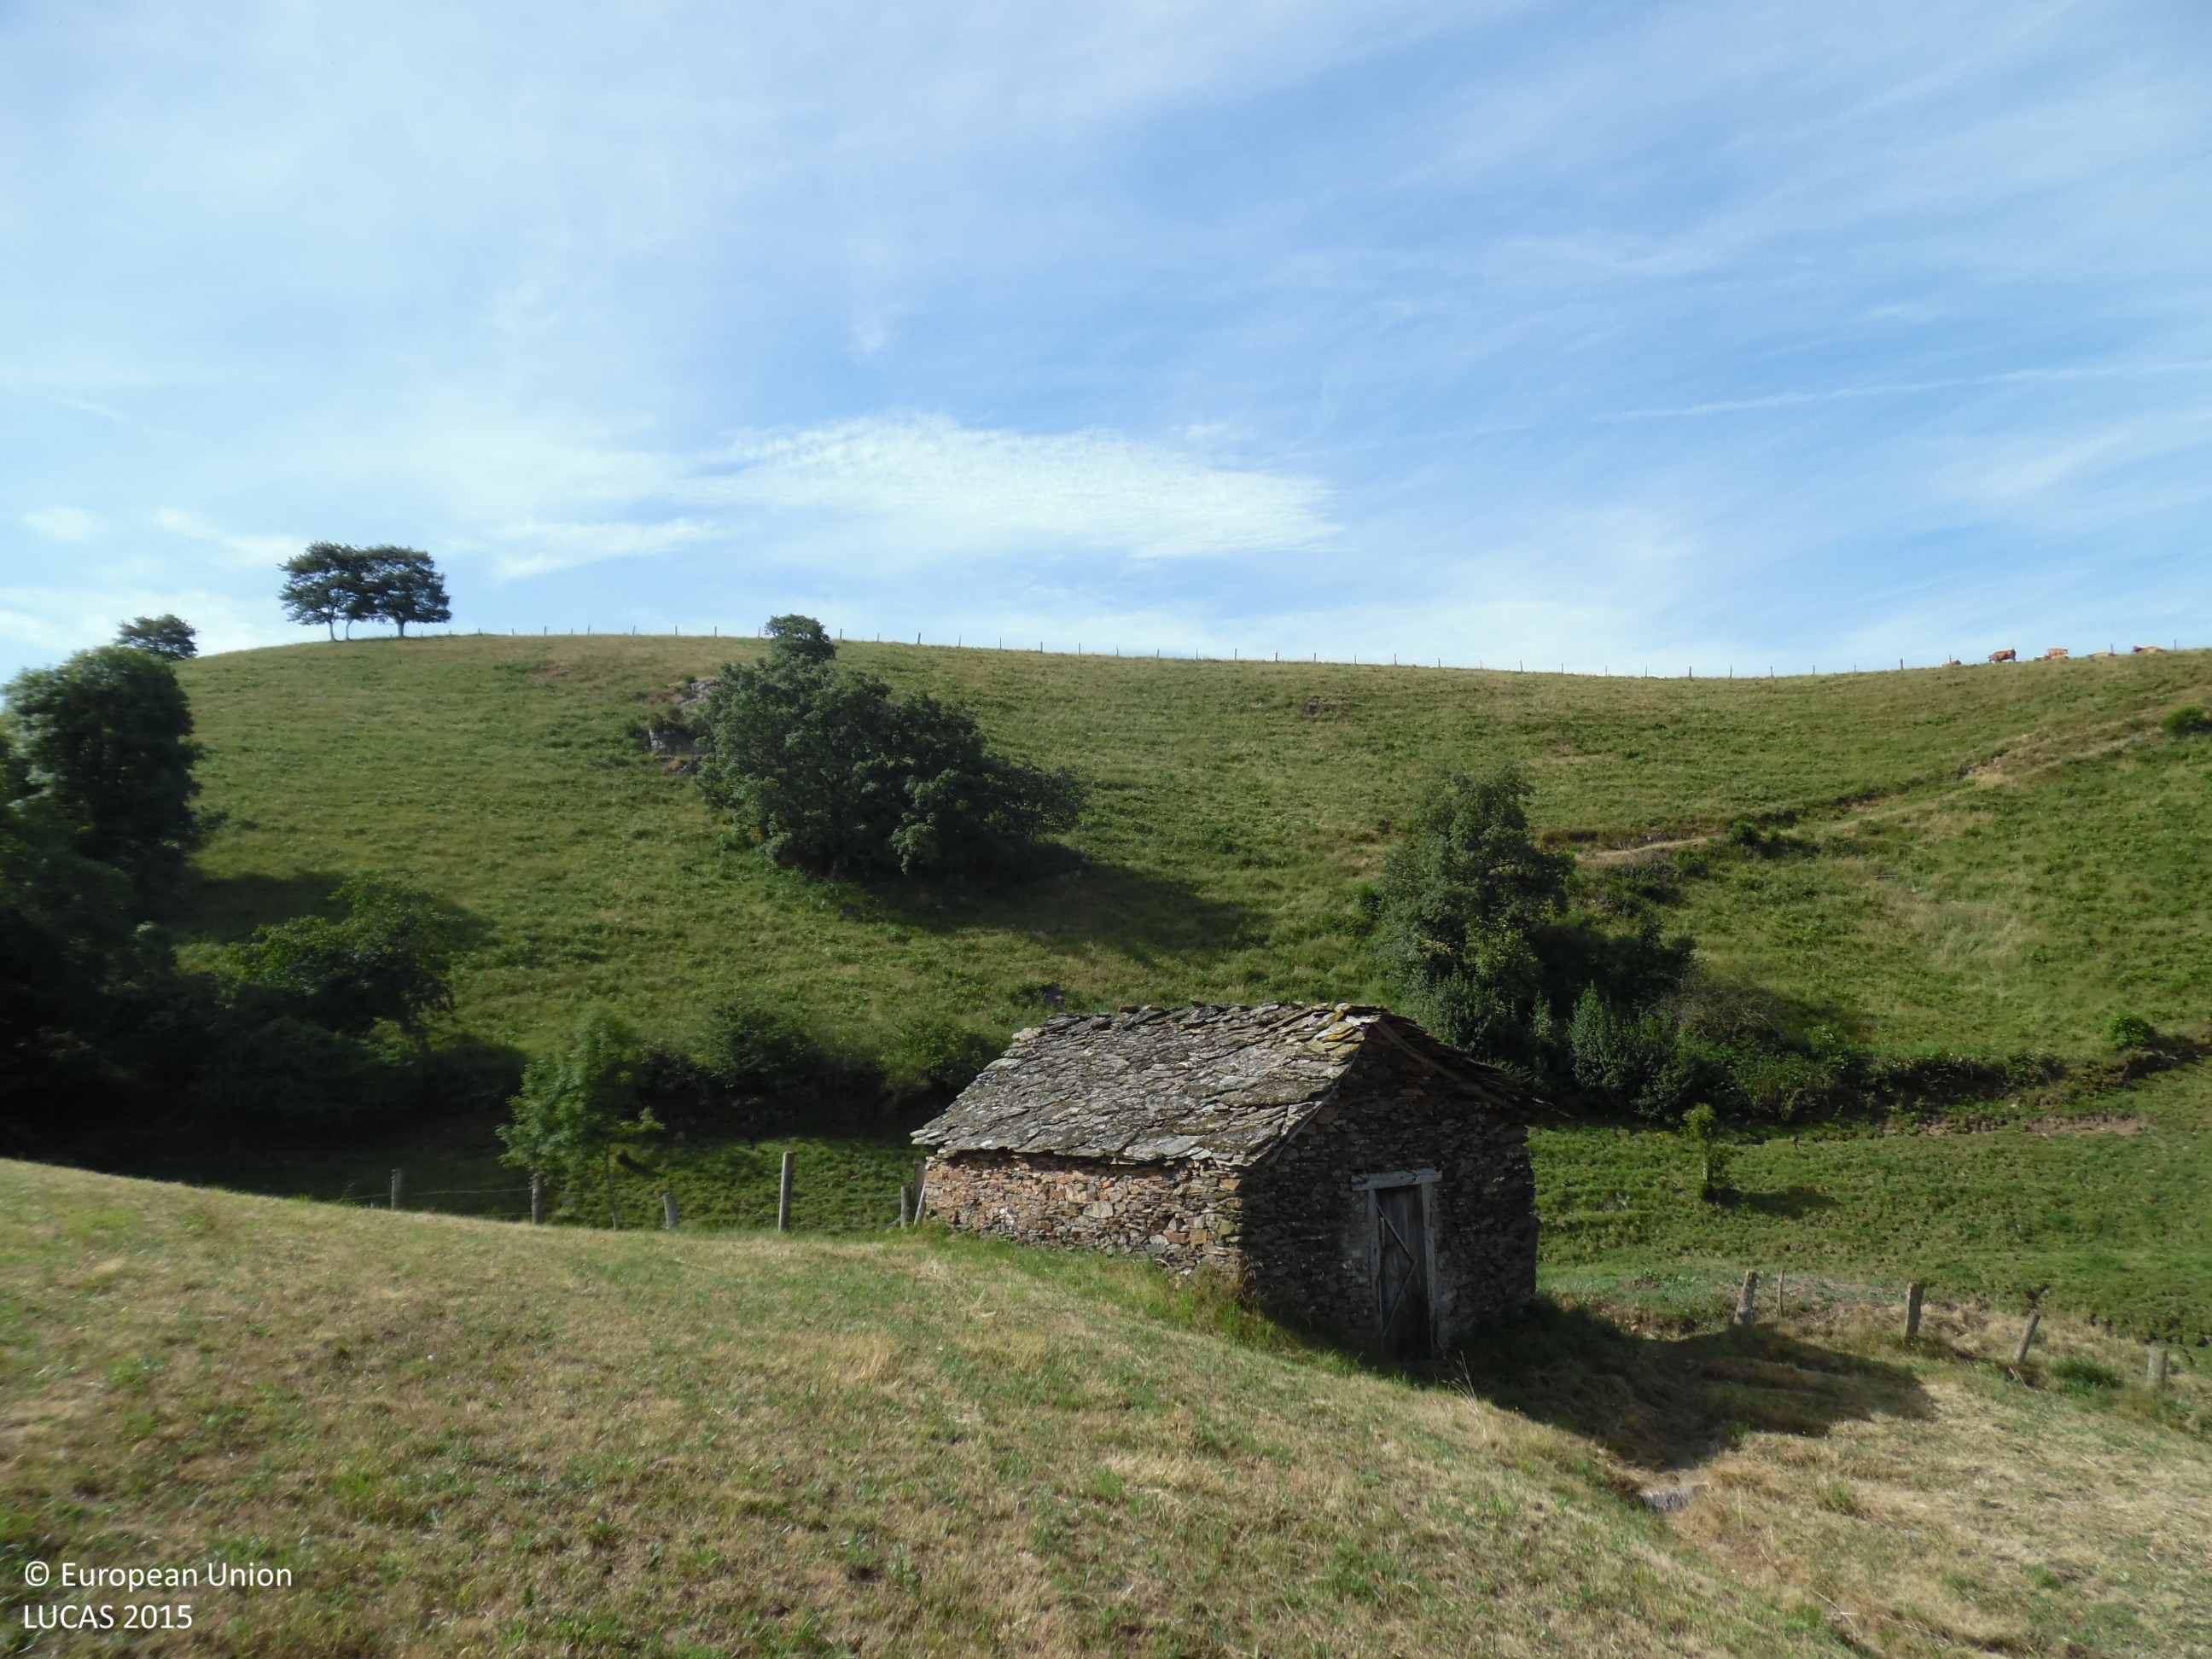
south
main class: Cropland
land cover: Temporary grasslands
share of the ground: > 75 %
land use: Agriculture (excluding fallow land and kitchen gardens)
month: July
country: ES
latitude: 43.1680
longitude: -6.5978
